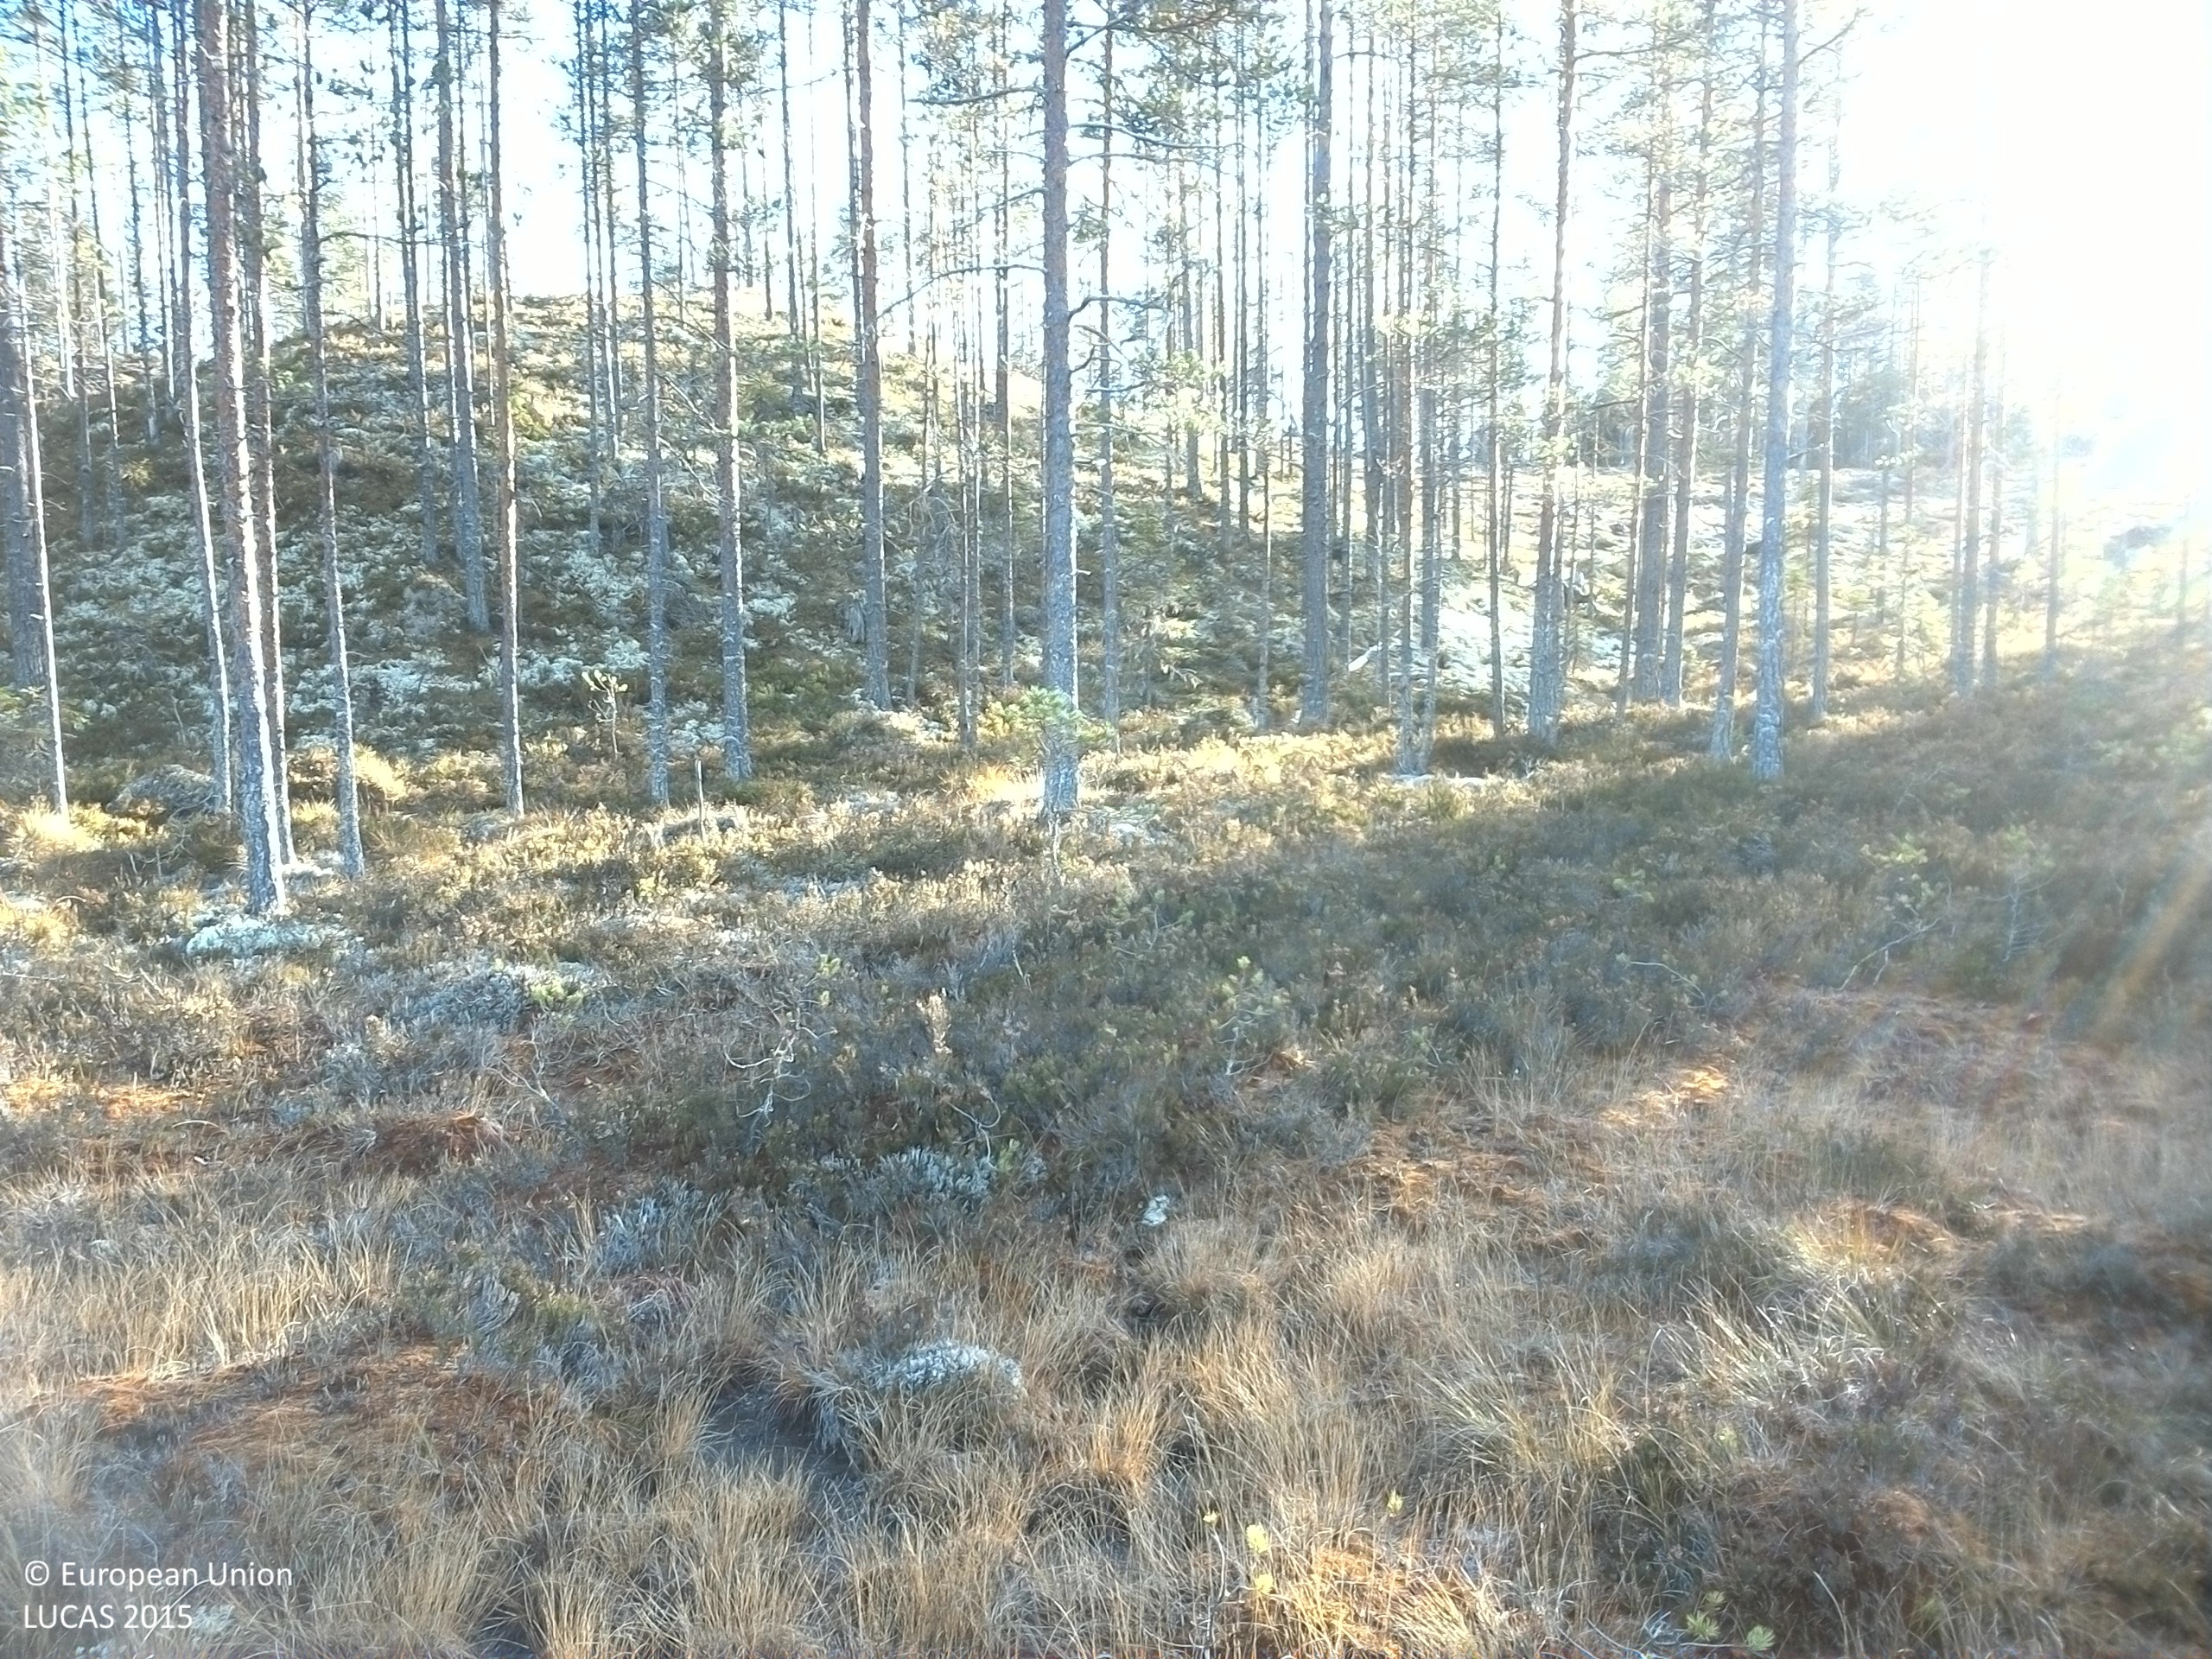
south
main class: Woodland
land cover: Pine dominated coniferous woodland
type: boreal forest
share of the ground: 10 - 25 %
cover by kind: lichens and mosses 40 %, shrubs 25 %, coniferous forest trees 20 %, herbaceous plants 15 %
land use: Semi-natural and natural areas not in use
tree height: < 5 m
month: October
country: SE
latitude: 61.1776
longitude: 14.3561
